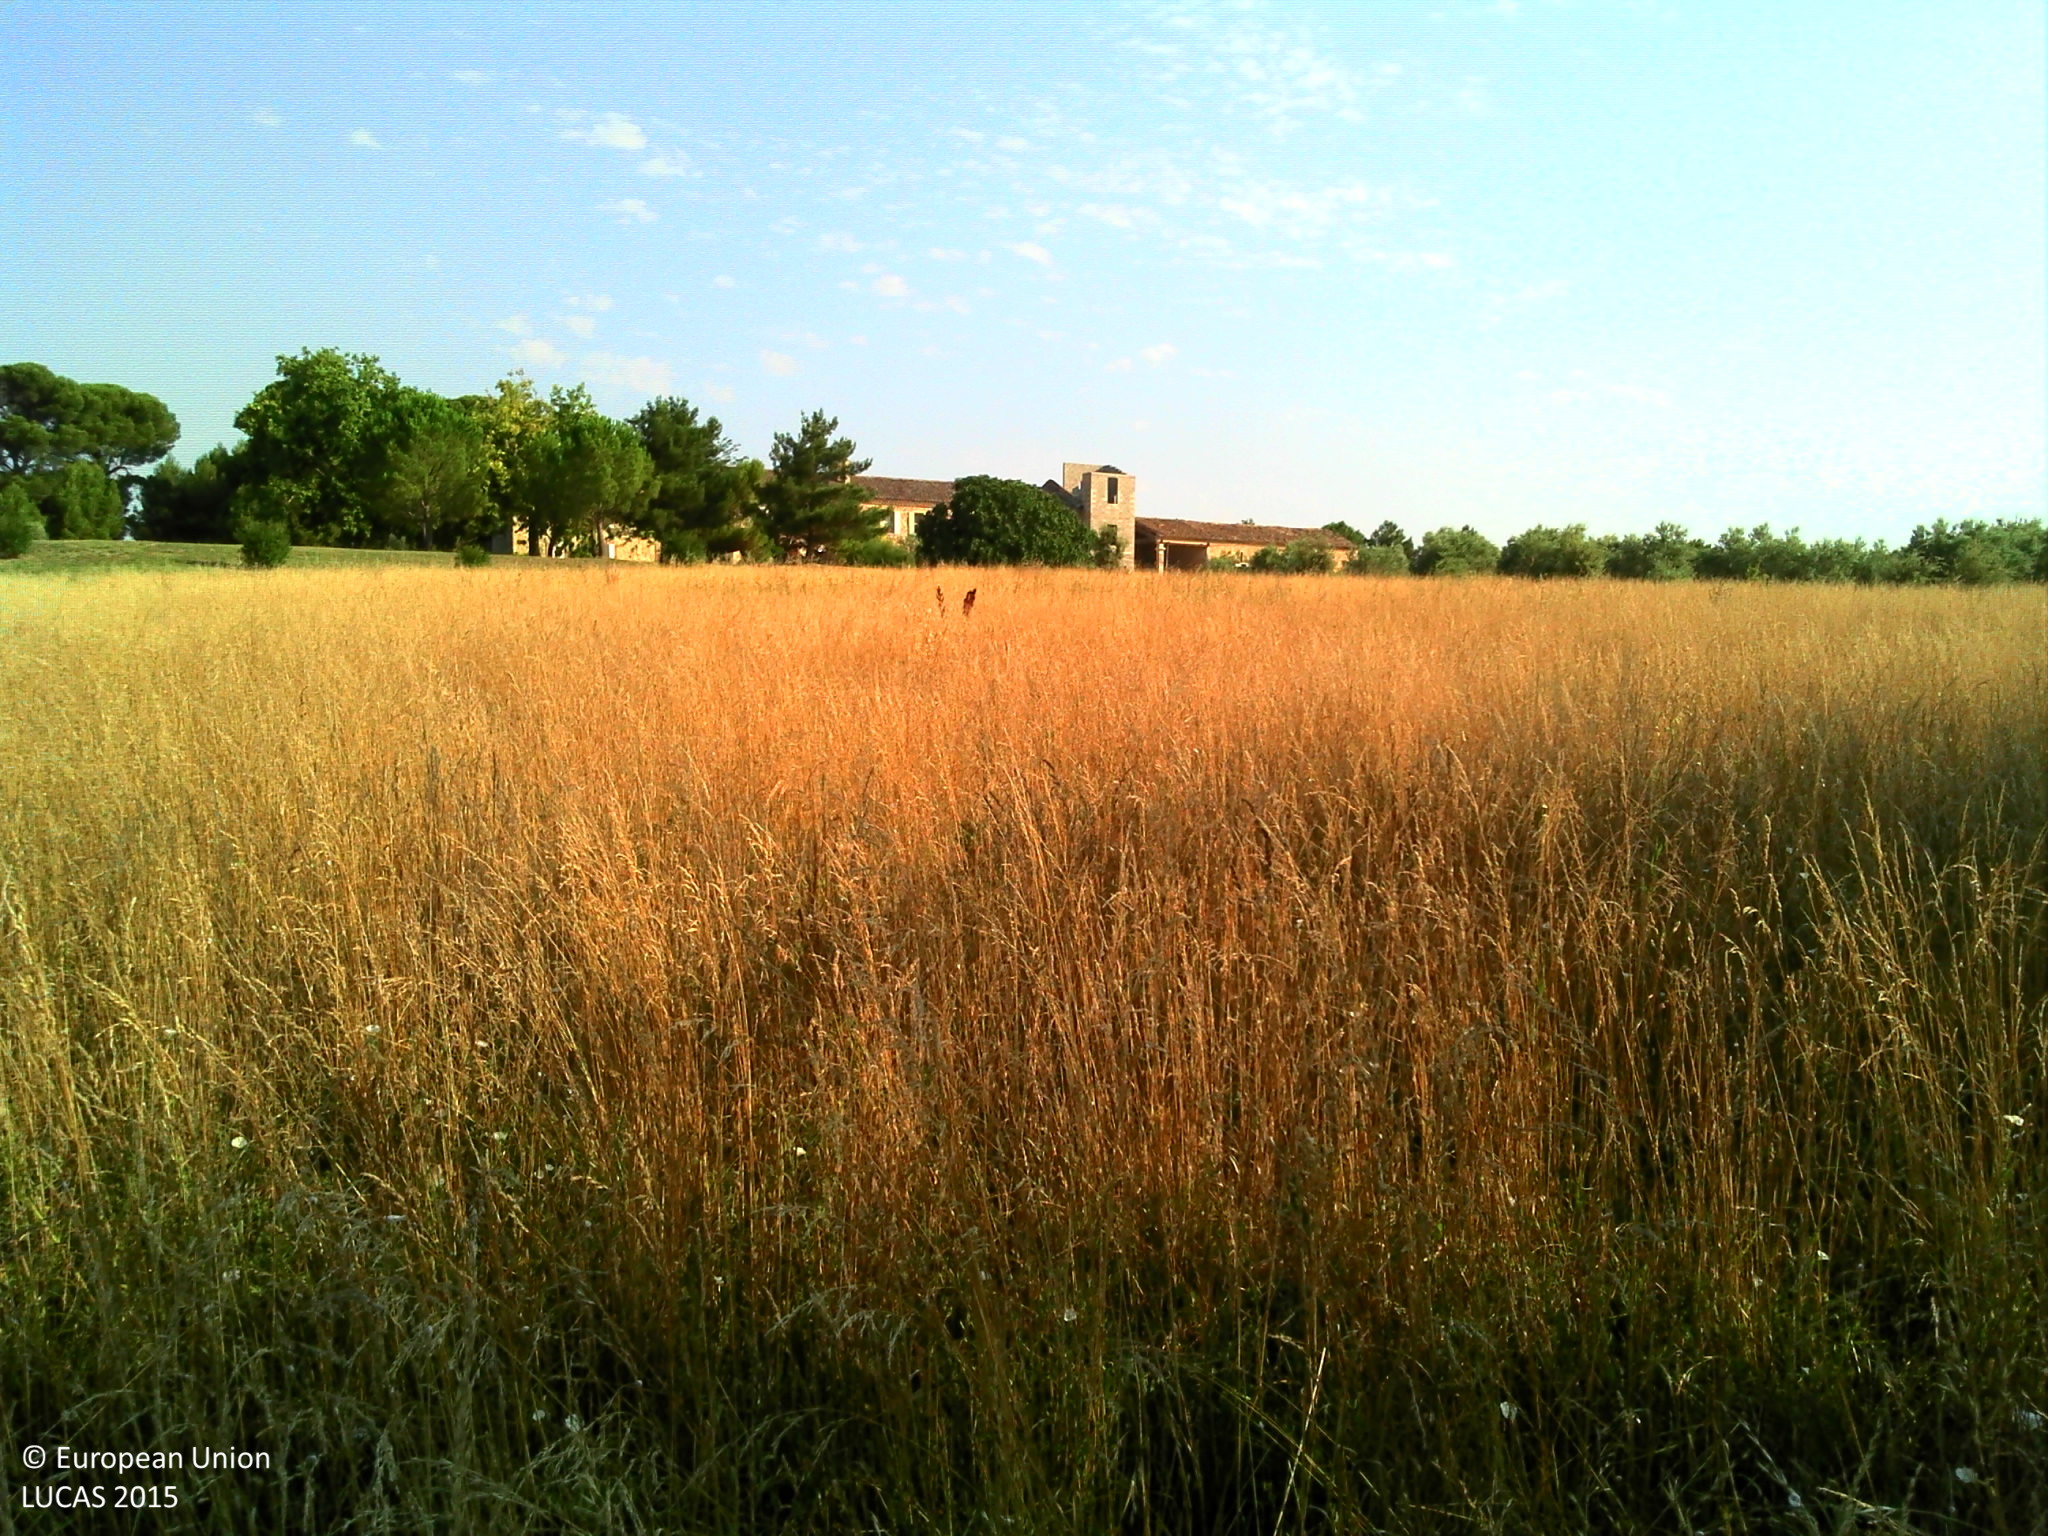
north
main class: Grassland
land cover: Grassland without tree/shrub cover
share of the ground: > 75 %
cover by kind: herbaceous plants 100 %
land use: Agriculture (excluding fallow land and kitchen gardens)
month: July
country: FR
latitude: 43.9607
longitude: 5.0359
